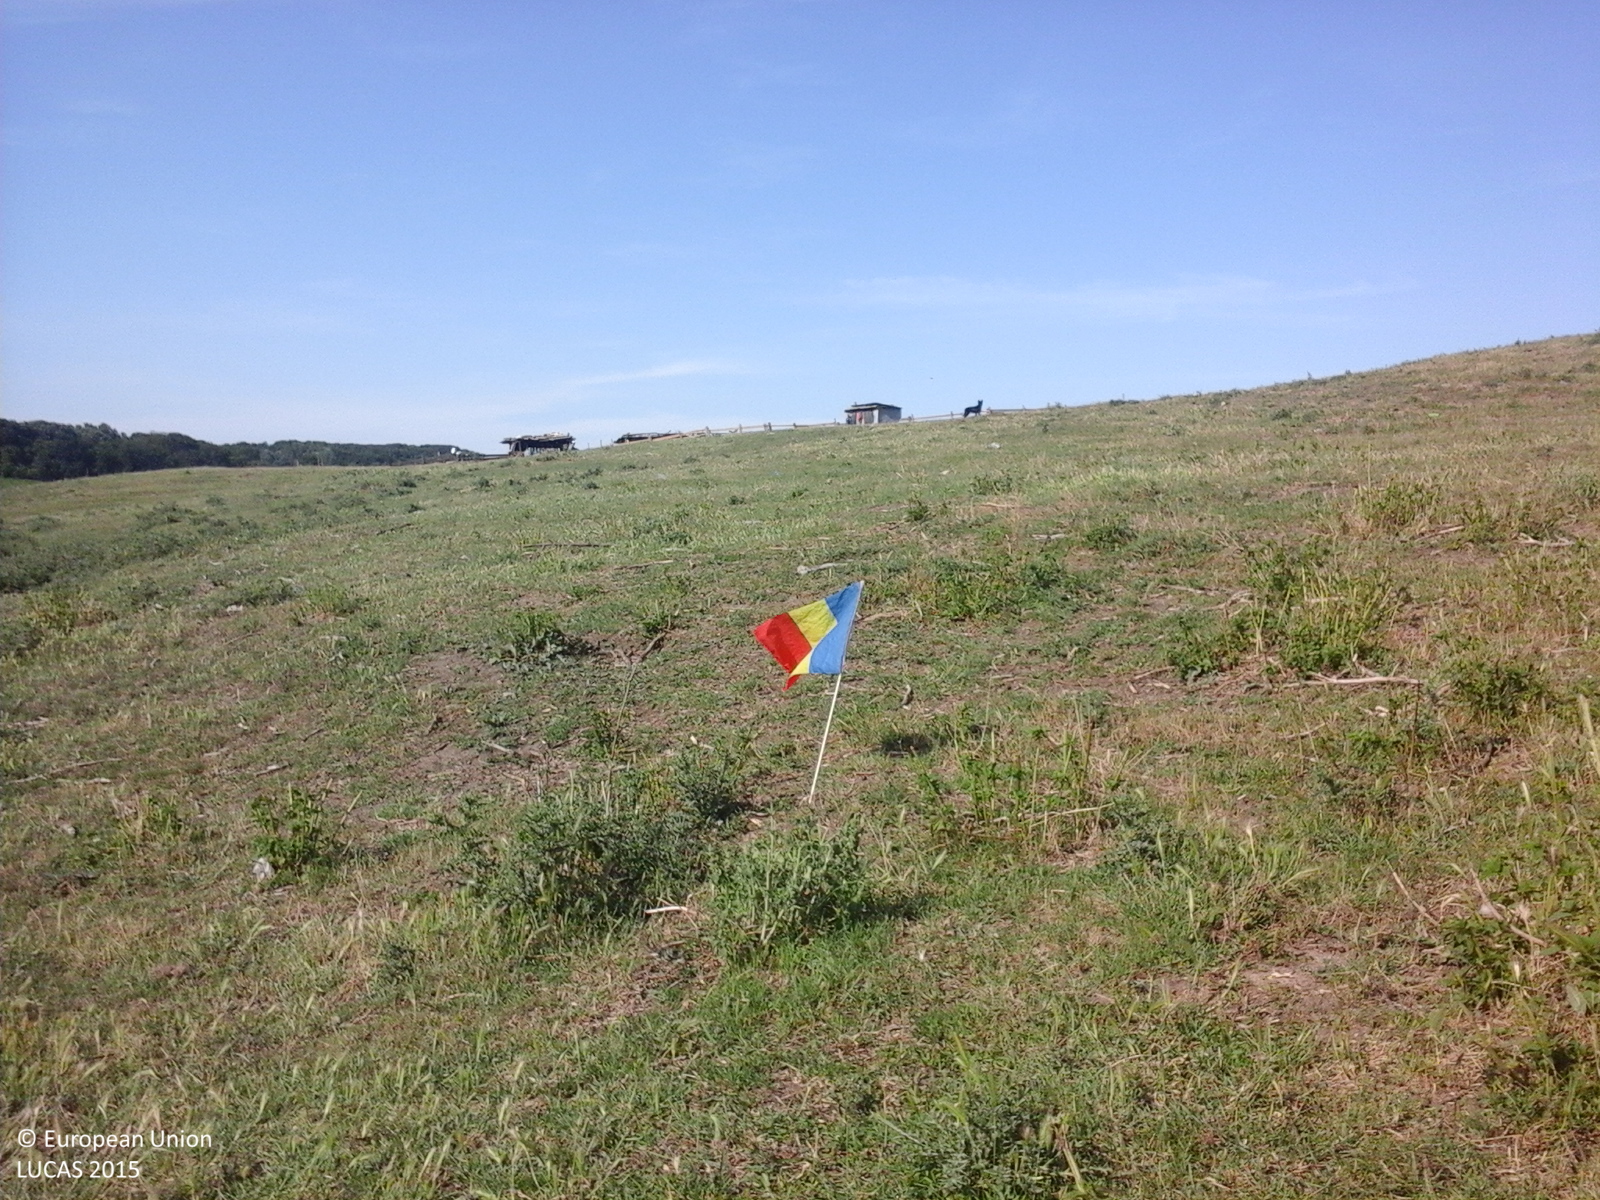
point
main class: Grassland
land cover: Grassland without tree/shrub cover
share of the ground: > 75 %
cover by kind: herbaceous plants 100 %
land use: Agriculture (excluding fallow land and kitchen gardens)
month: June
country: RO
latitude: 47.0868
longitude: 26.9191
